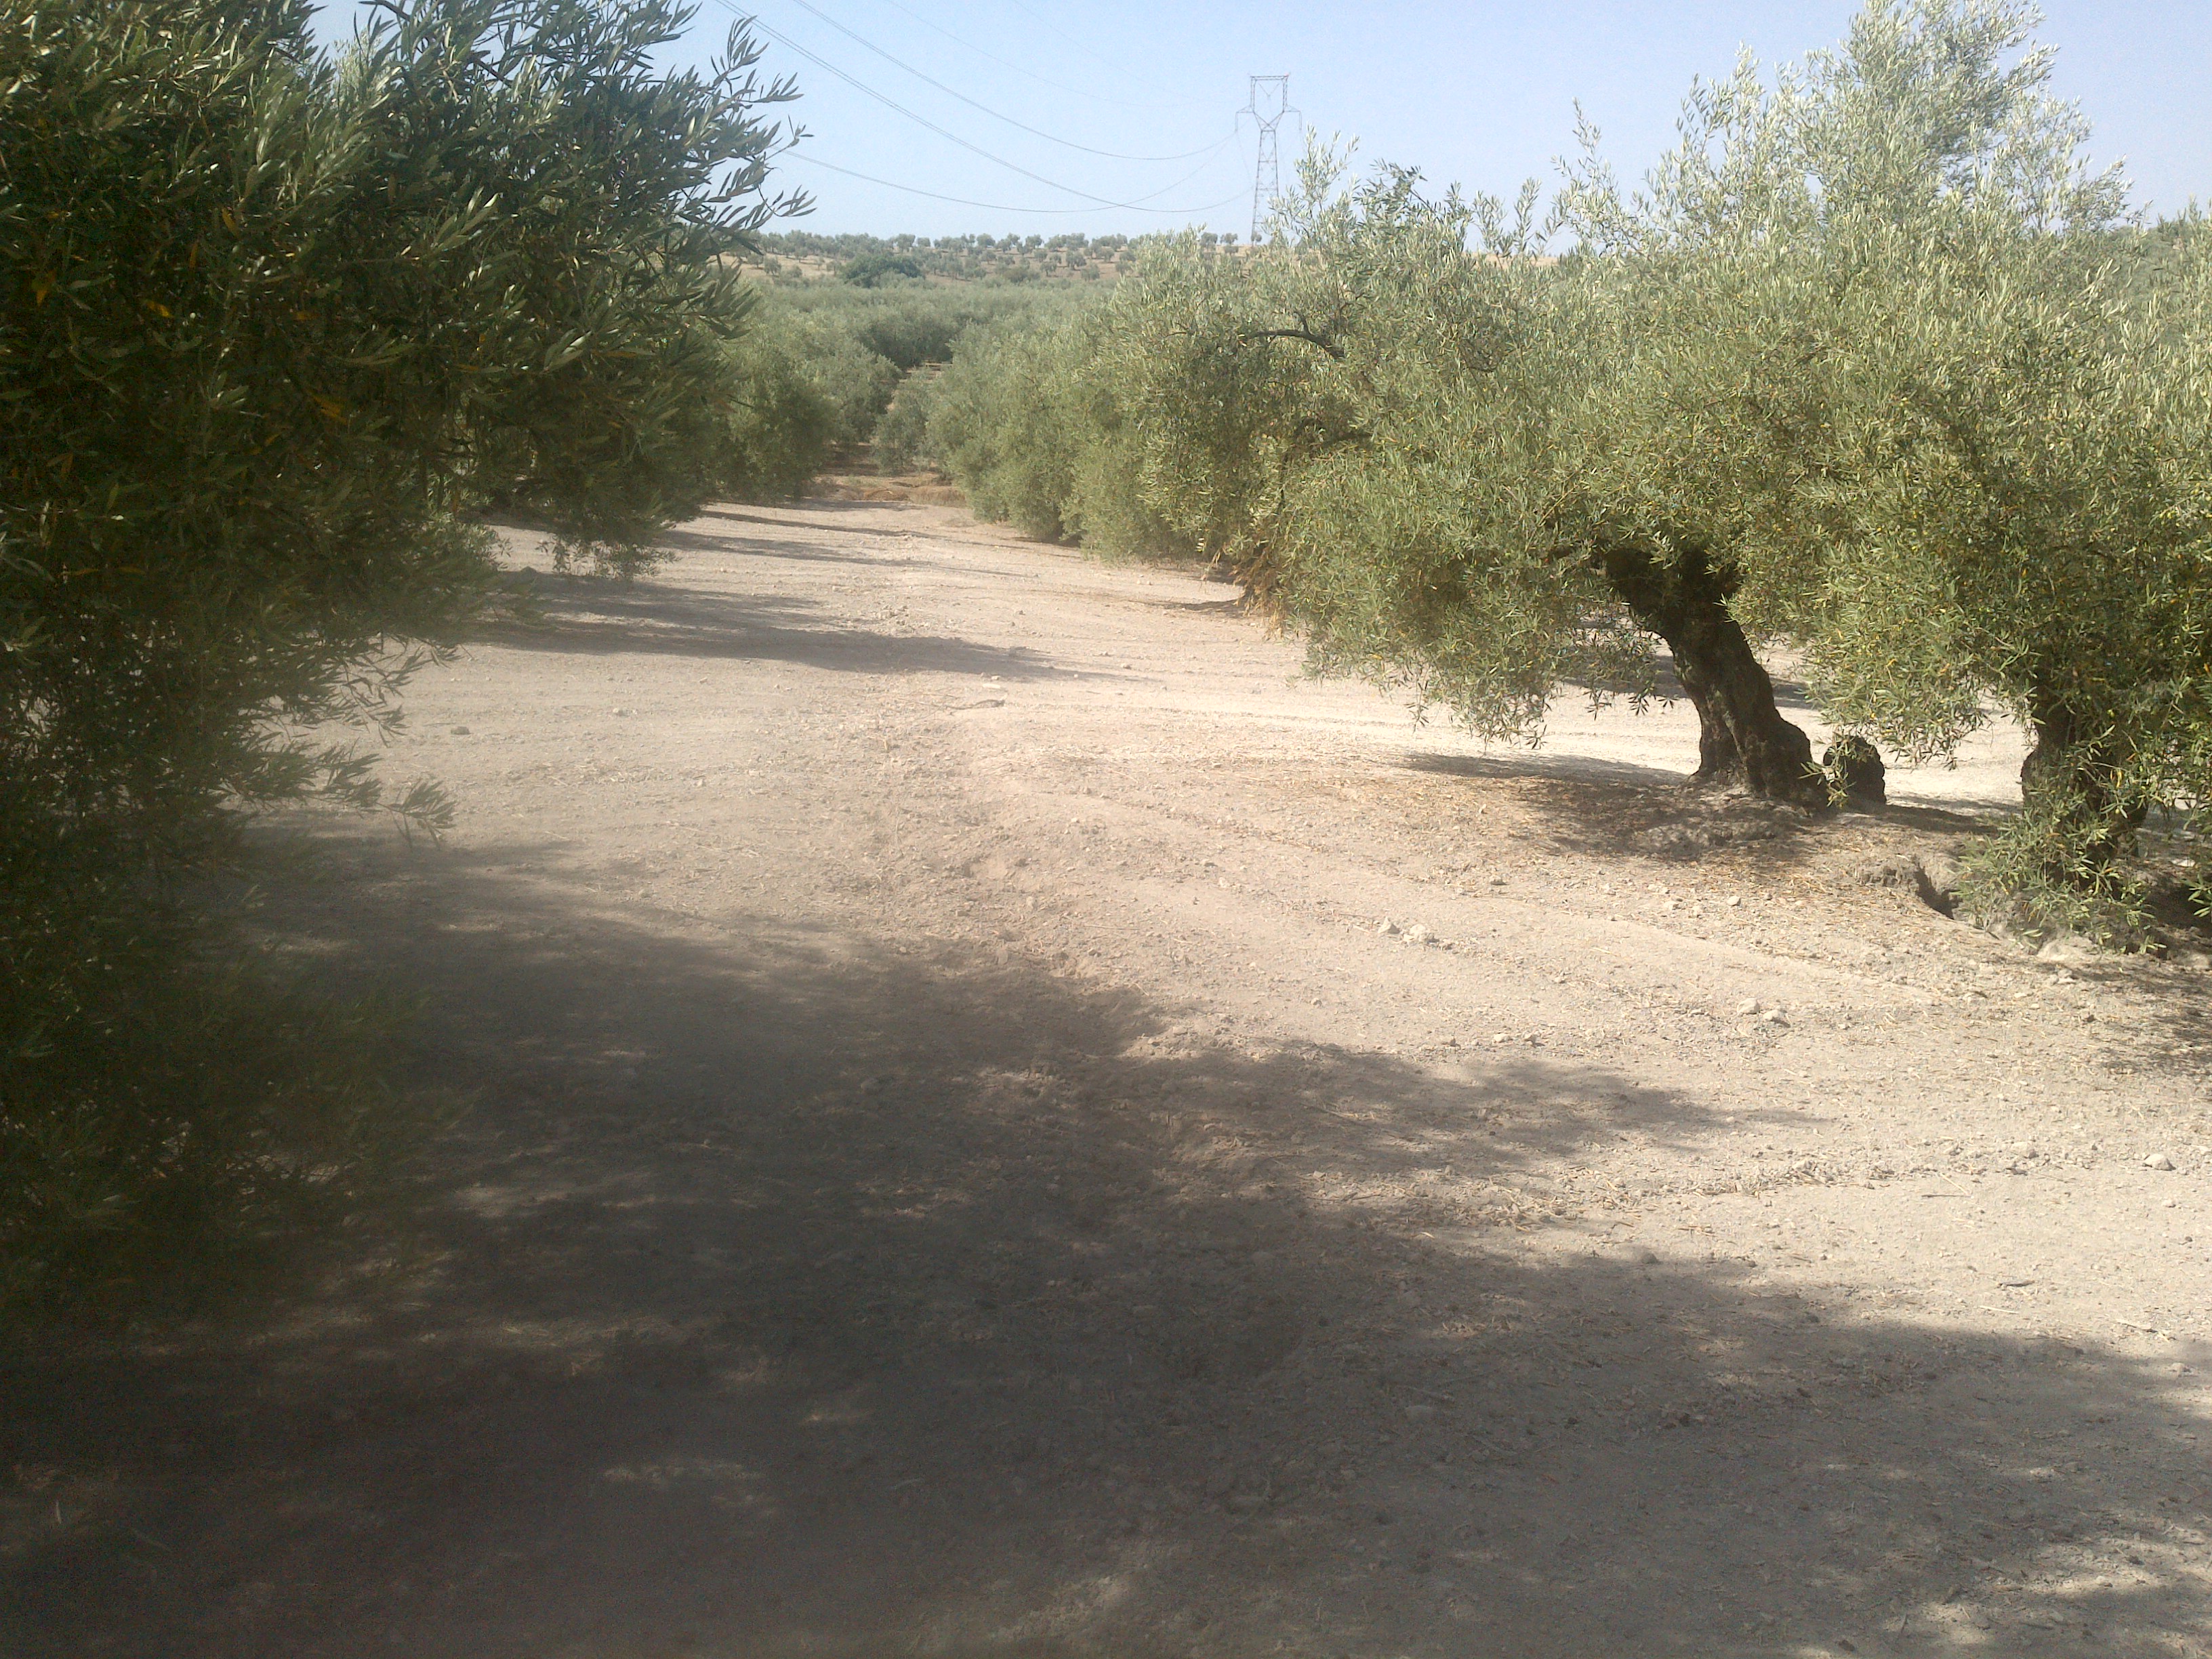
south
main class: Cropland
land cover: Olive groves
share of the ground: 50 - 75 %
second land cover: Other bare soil
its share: > 75 %
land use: Agriculture (excluding fallow land and kitchen gardens)
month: July
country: ES
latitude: 37.3958
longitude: -4.5408
